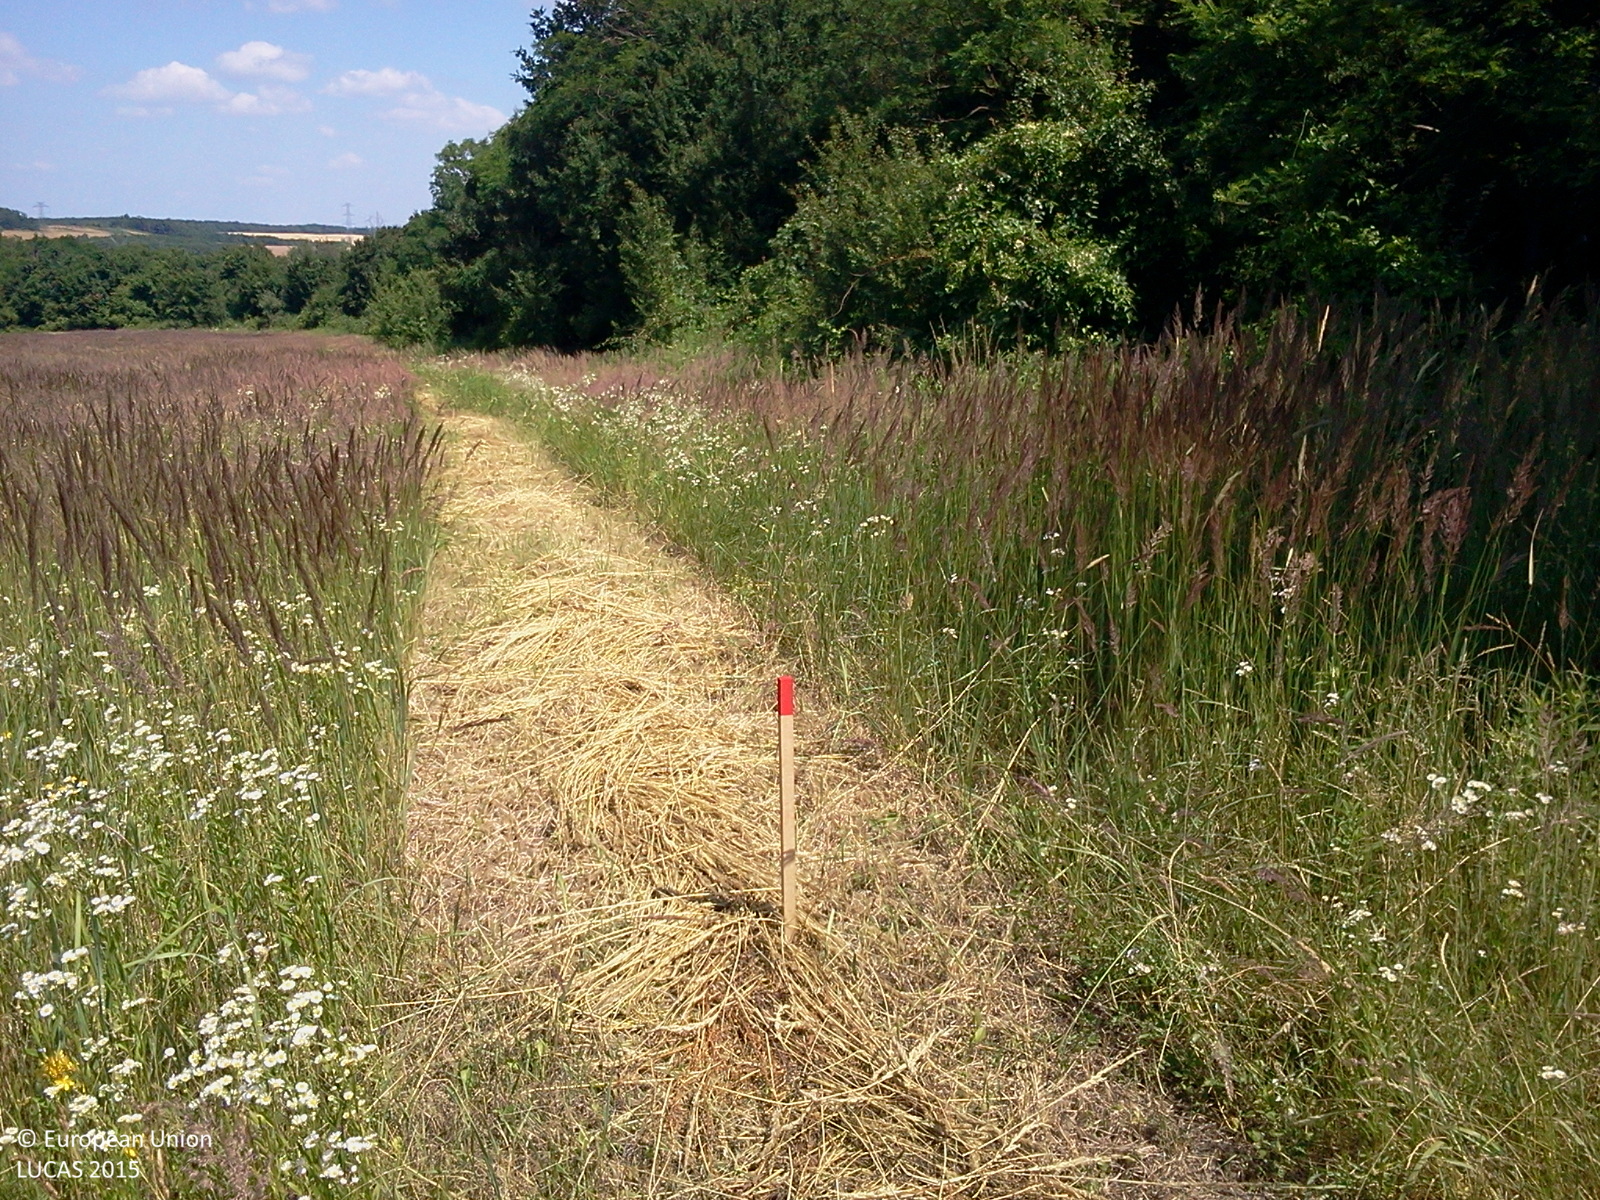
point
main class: Grassland
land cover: Grassland without tree/shrub cover
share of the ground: > 75 %
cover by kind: herbaceous plants 100 %
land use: Agriculture (excluding fallow land and kitchen gardens)
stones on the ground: < 10 %
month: June
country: HU
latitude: 46.7667
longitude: 17.0880
